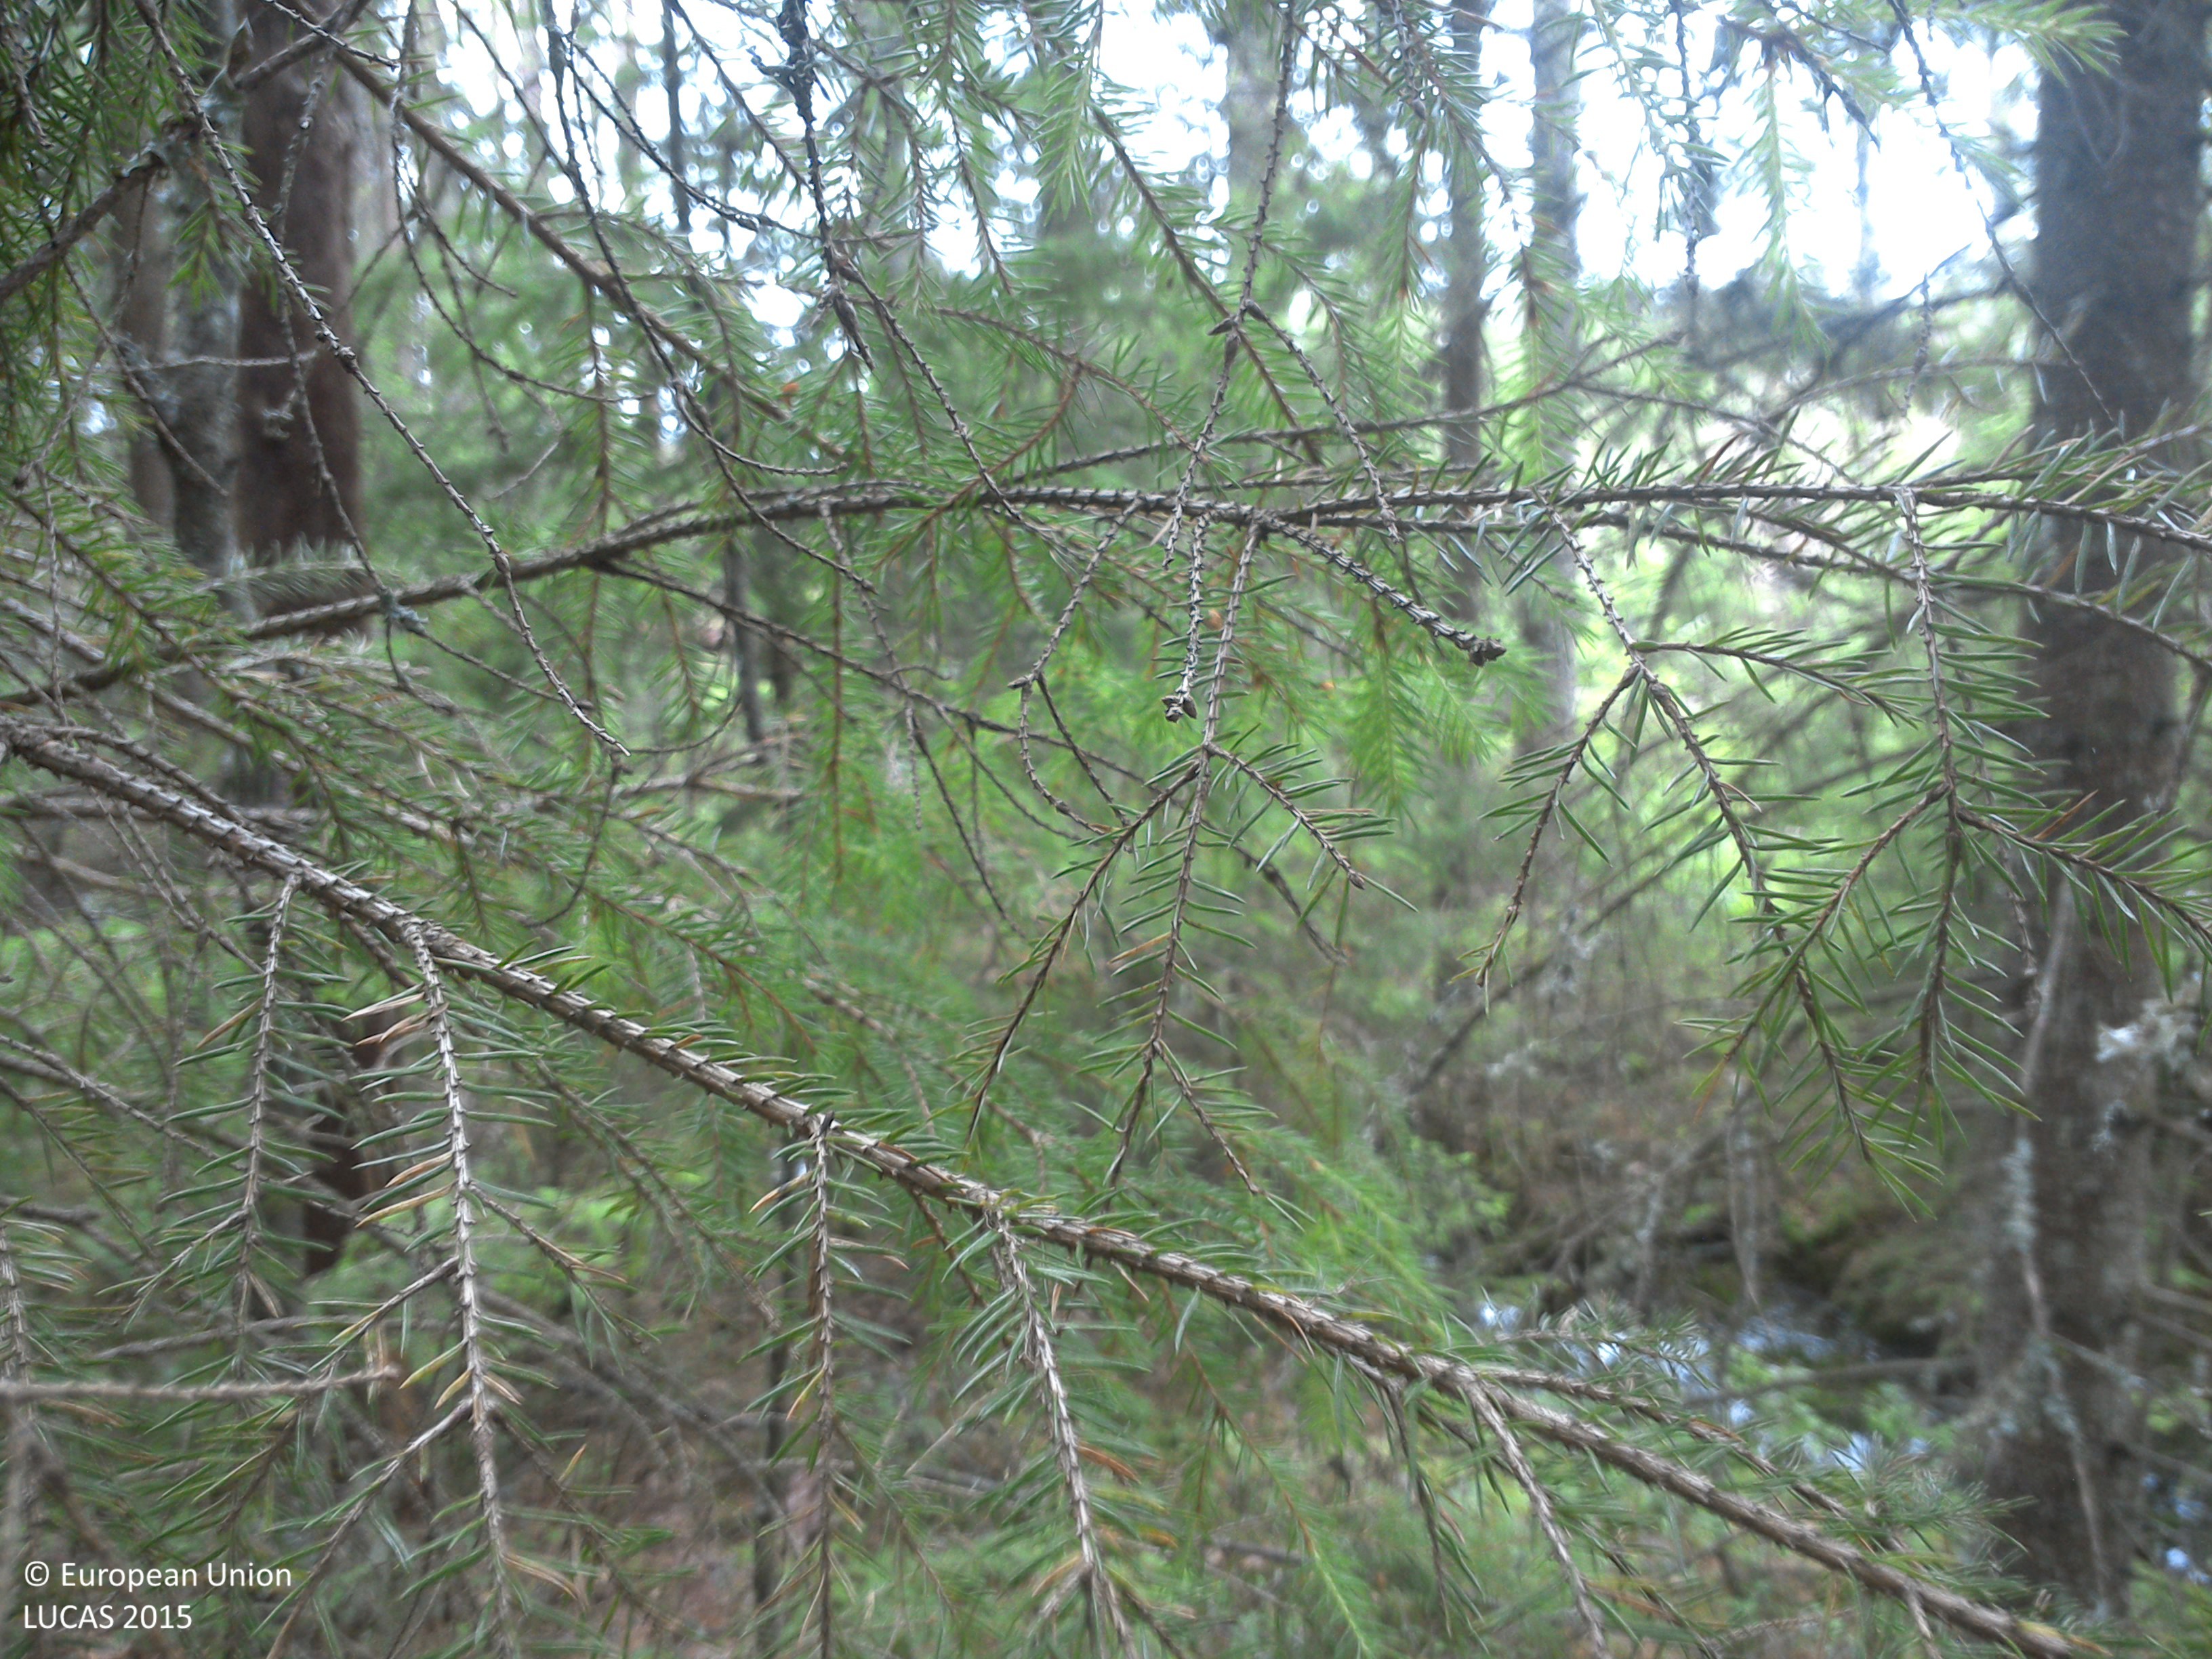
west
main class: Woodland
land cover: Spruce dominated coniferous woodland
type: boreal forest
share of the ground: > 75 %
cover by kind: coniferous forest trees 75 %, lichens and mosses 25 %
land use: Forestry
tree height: > 5 m
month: June
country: SE
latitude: 58.2471
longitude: 15.6001
